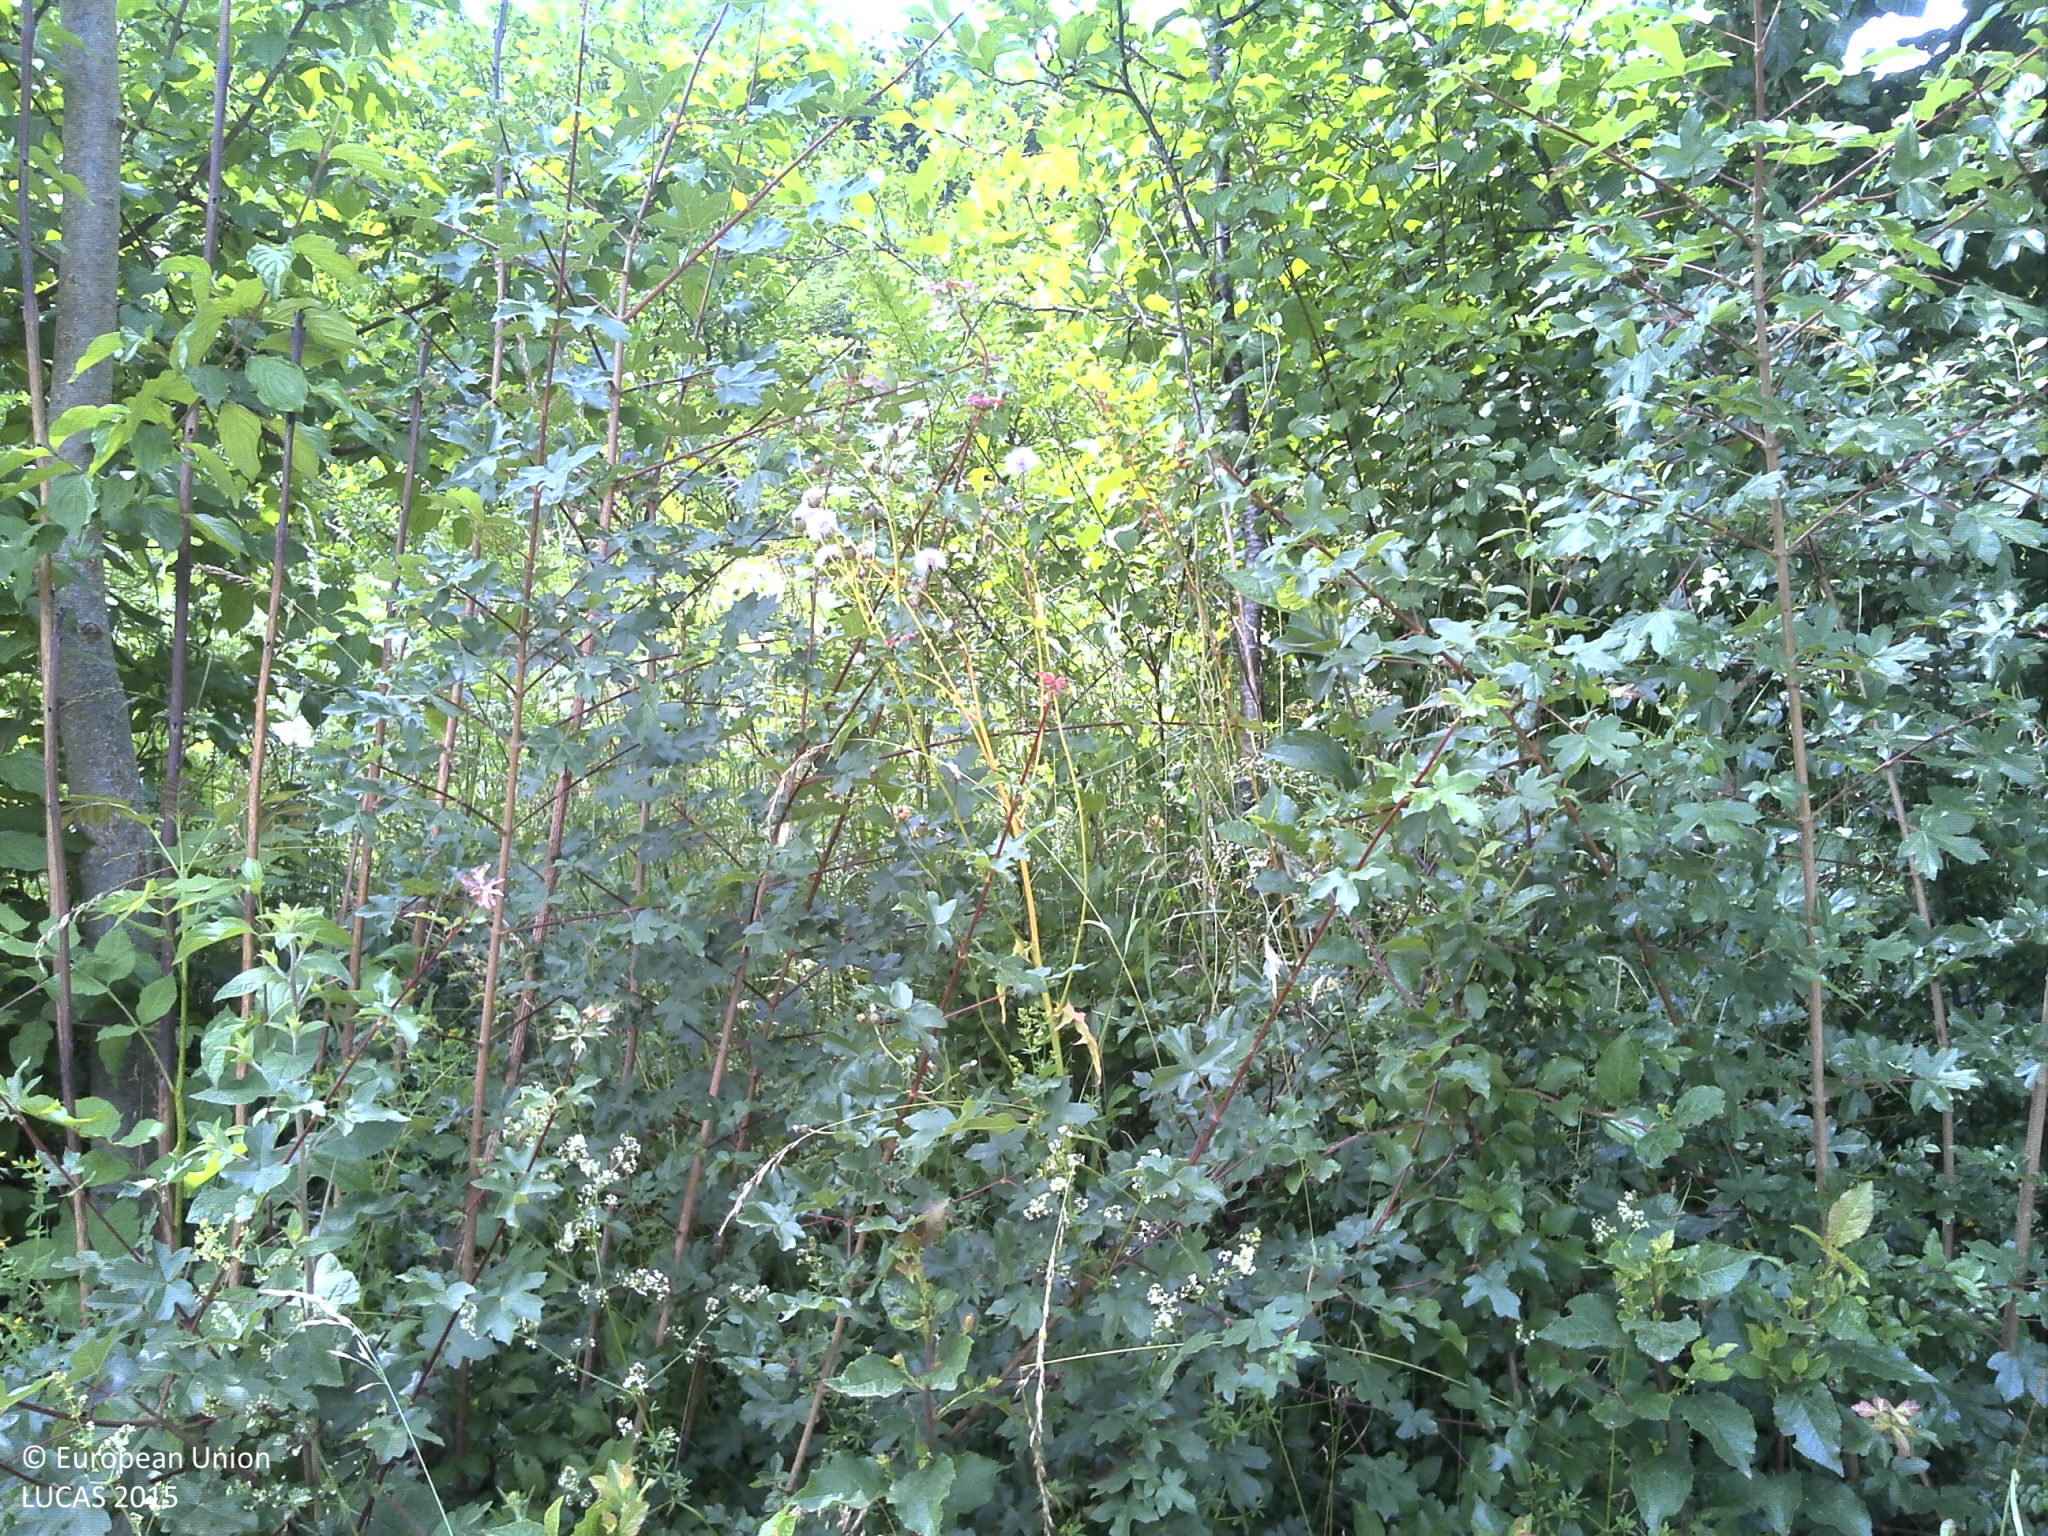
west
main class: Woodland
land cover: Broadleaved woodland
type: beech forest
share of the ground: > 75 %
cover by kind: broadleaved forest trees 100 %
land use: Semi-natural and natural areas not in use
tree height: > 5 m
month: June
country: HR
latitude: 44.5430
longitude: 15.9220
